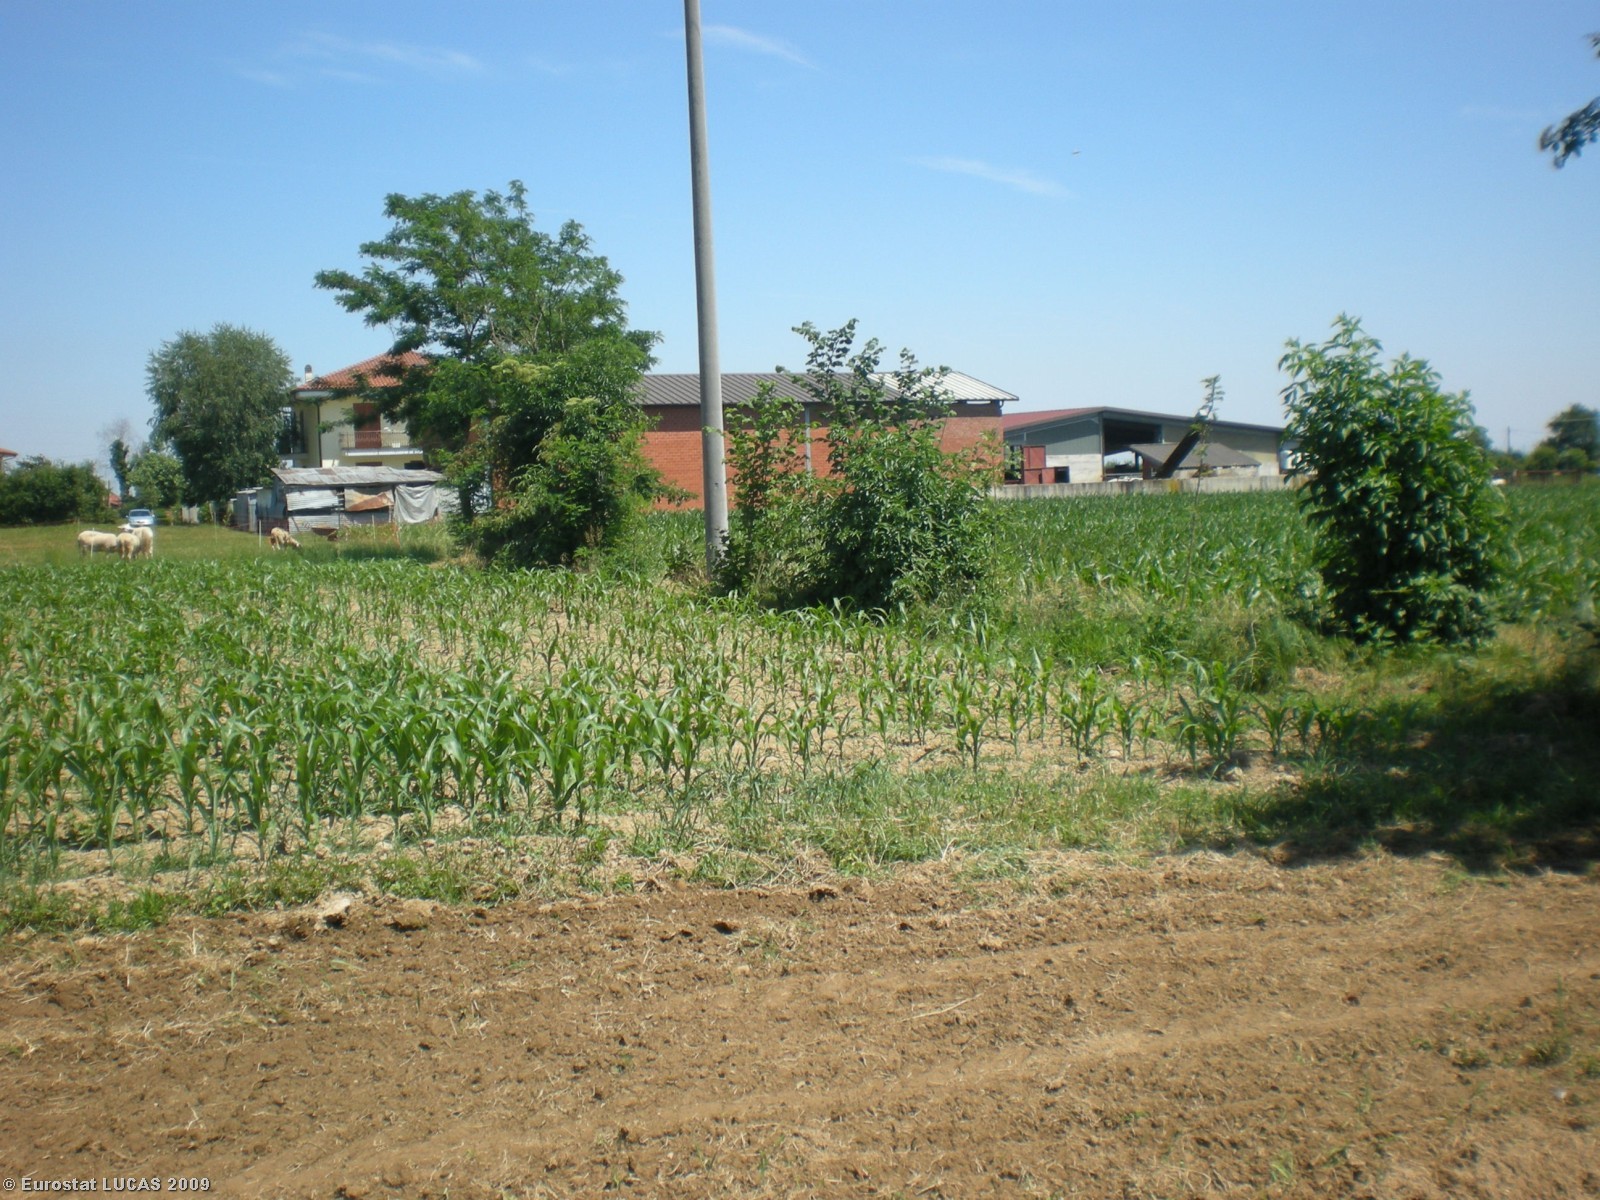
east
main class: Cropland
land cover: Other fruit trees and berries
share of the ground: < 10 %
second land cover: Bare land
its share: > 75 %
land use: Agriculture (excluding fallow land and kitchen gardens)
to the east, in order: Other fruit trees and berries; Bare land; Grassland with sparse tree/shrub cover; Maize; Managed hedges; Electric lines; Ditches and canals; Maize; Artificial constructions in urban areas; Managed hedges; Paved roads, cycling and walking lanes; Grass margins; Ditches and canals; Temporary grasslands; Clovers; Common wheat
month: June
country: IT
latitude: 44.7675
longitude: 7.3390
